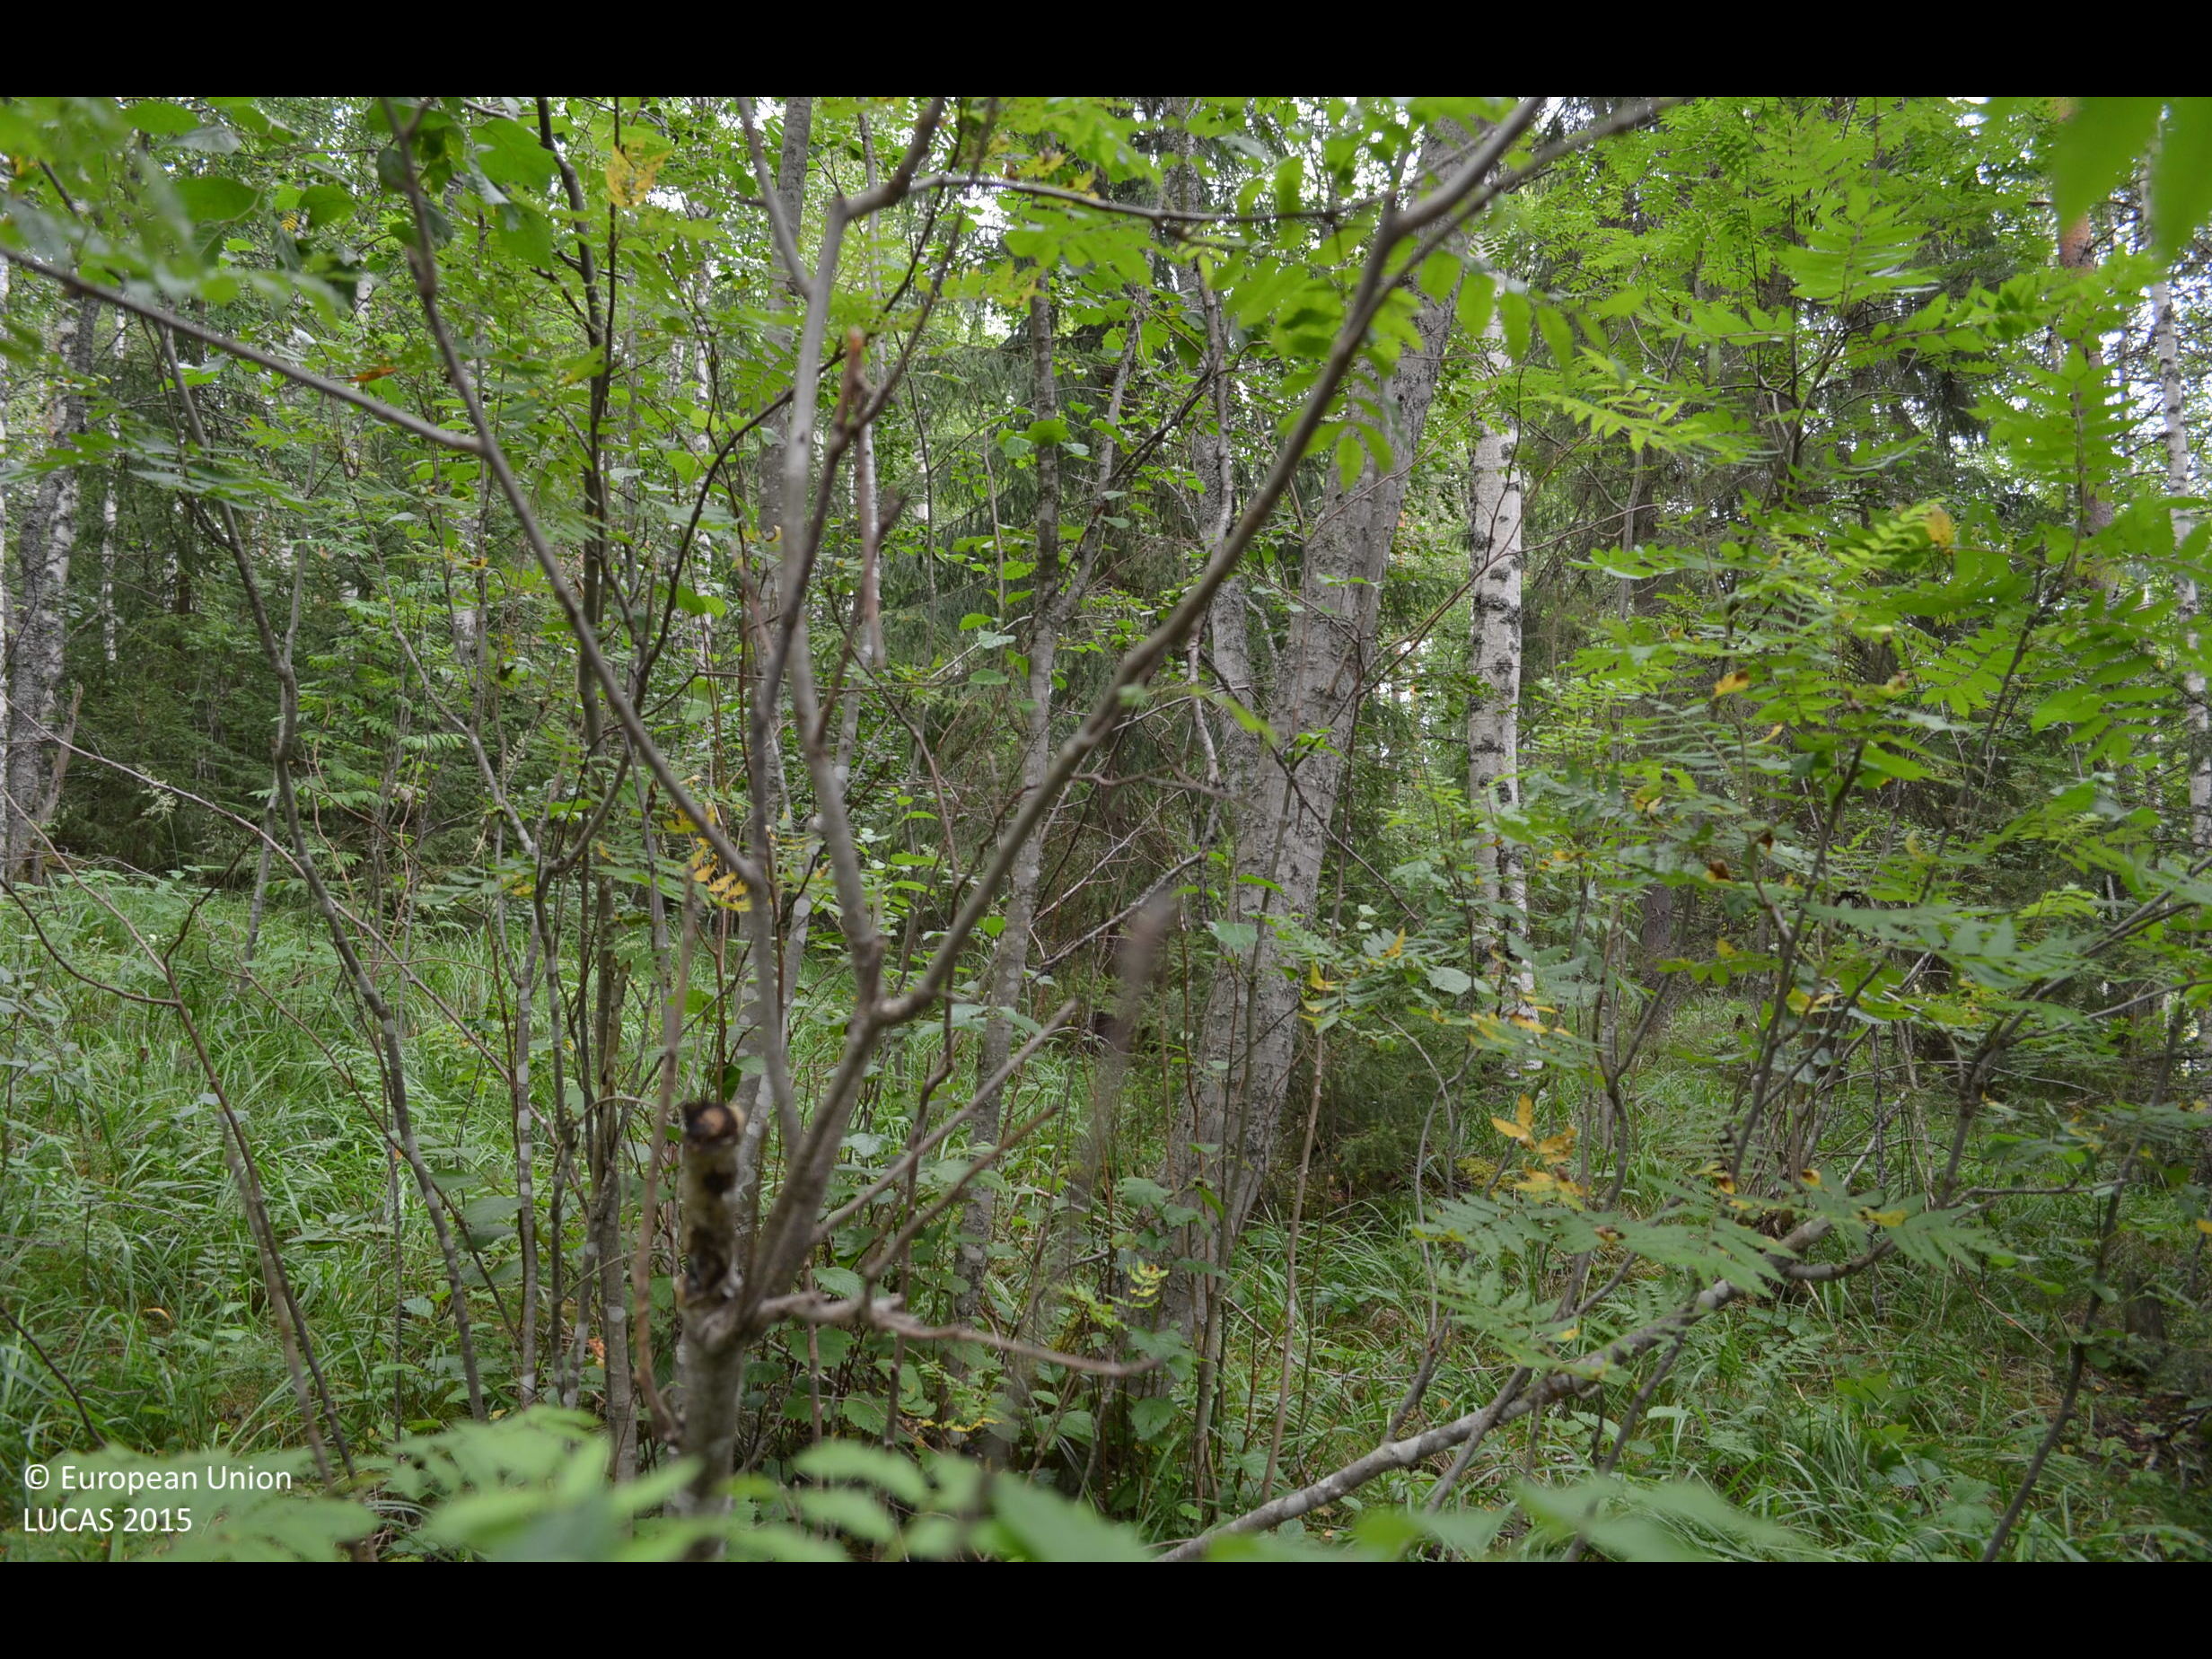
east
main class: Woodland
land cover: Other mixed woodland
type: boreal forest
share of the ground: > 75 %
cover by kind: broadleaved forest trees 45 %, coniferous forest trees 35 %, shrubs 20 %
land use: Forestry
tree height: > 5 m
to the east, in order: Other mixed woodland; Pine dominated coniferous woodland; Other mixed woodland
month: August
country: FI
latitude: 62.1801
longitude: 24.3216
